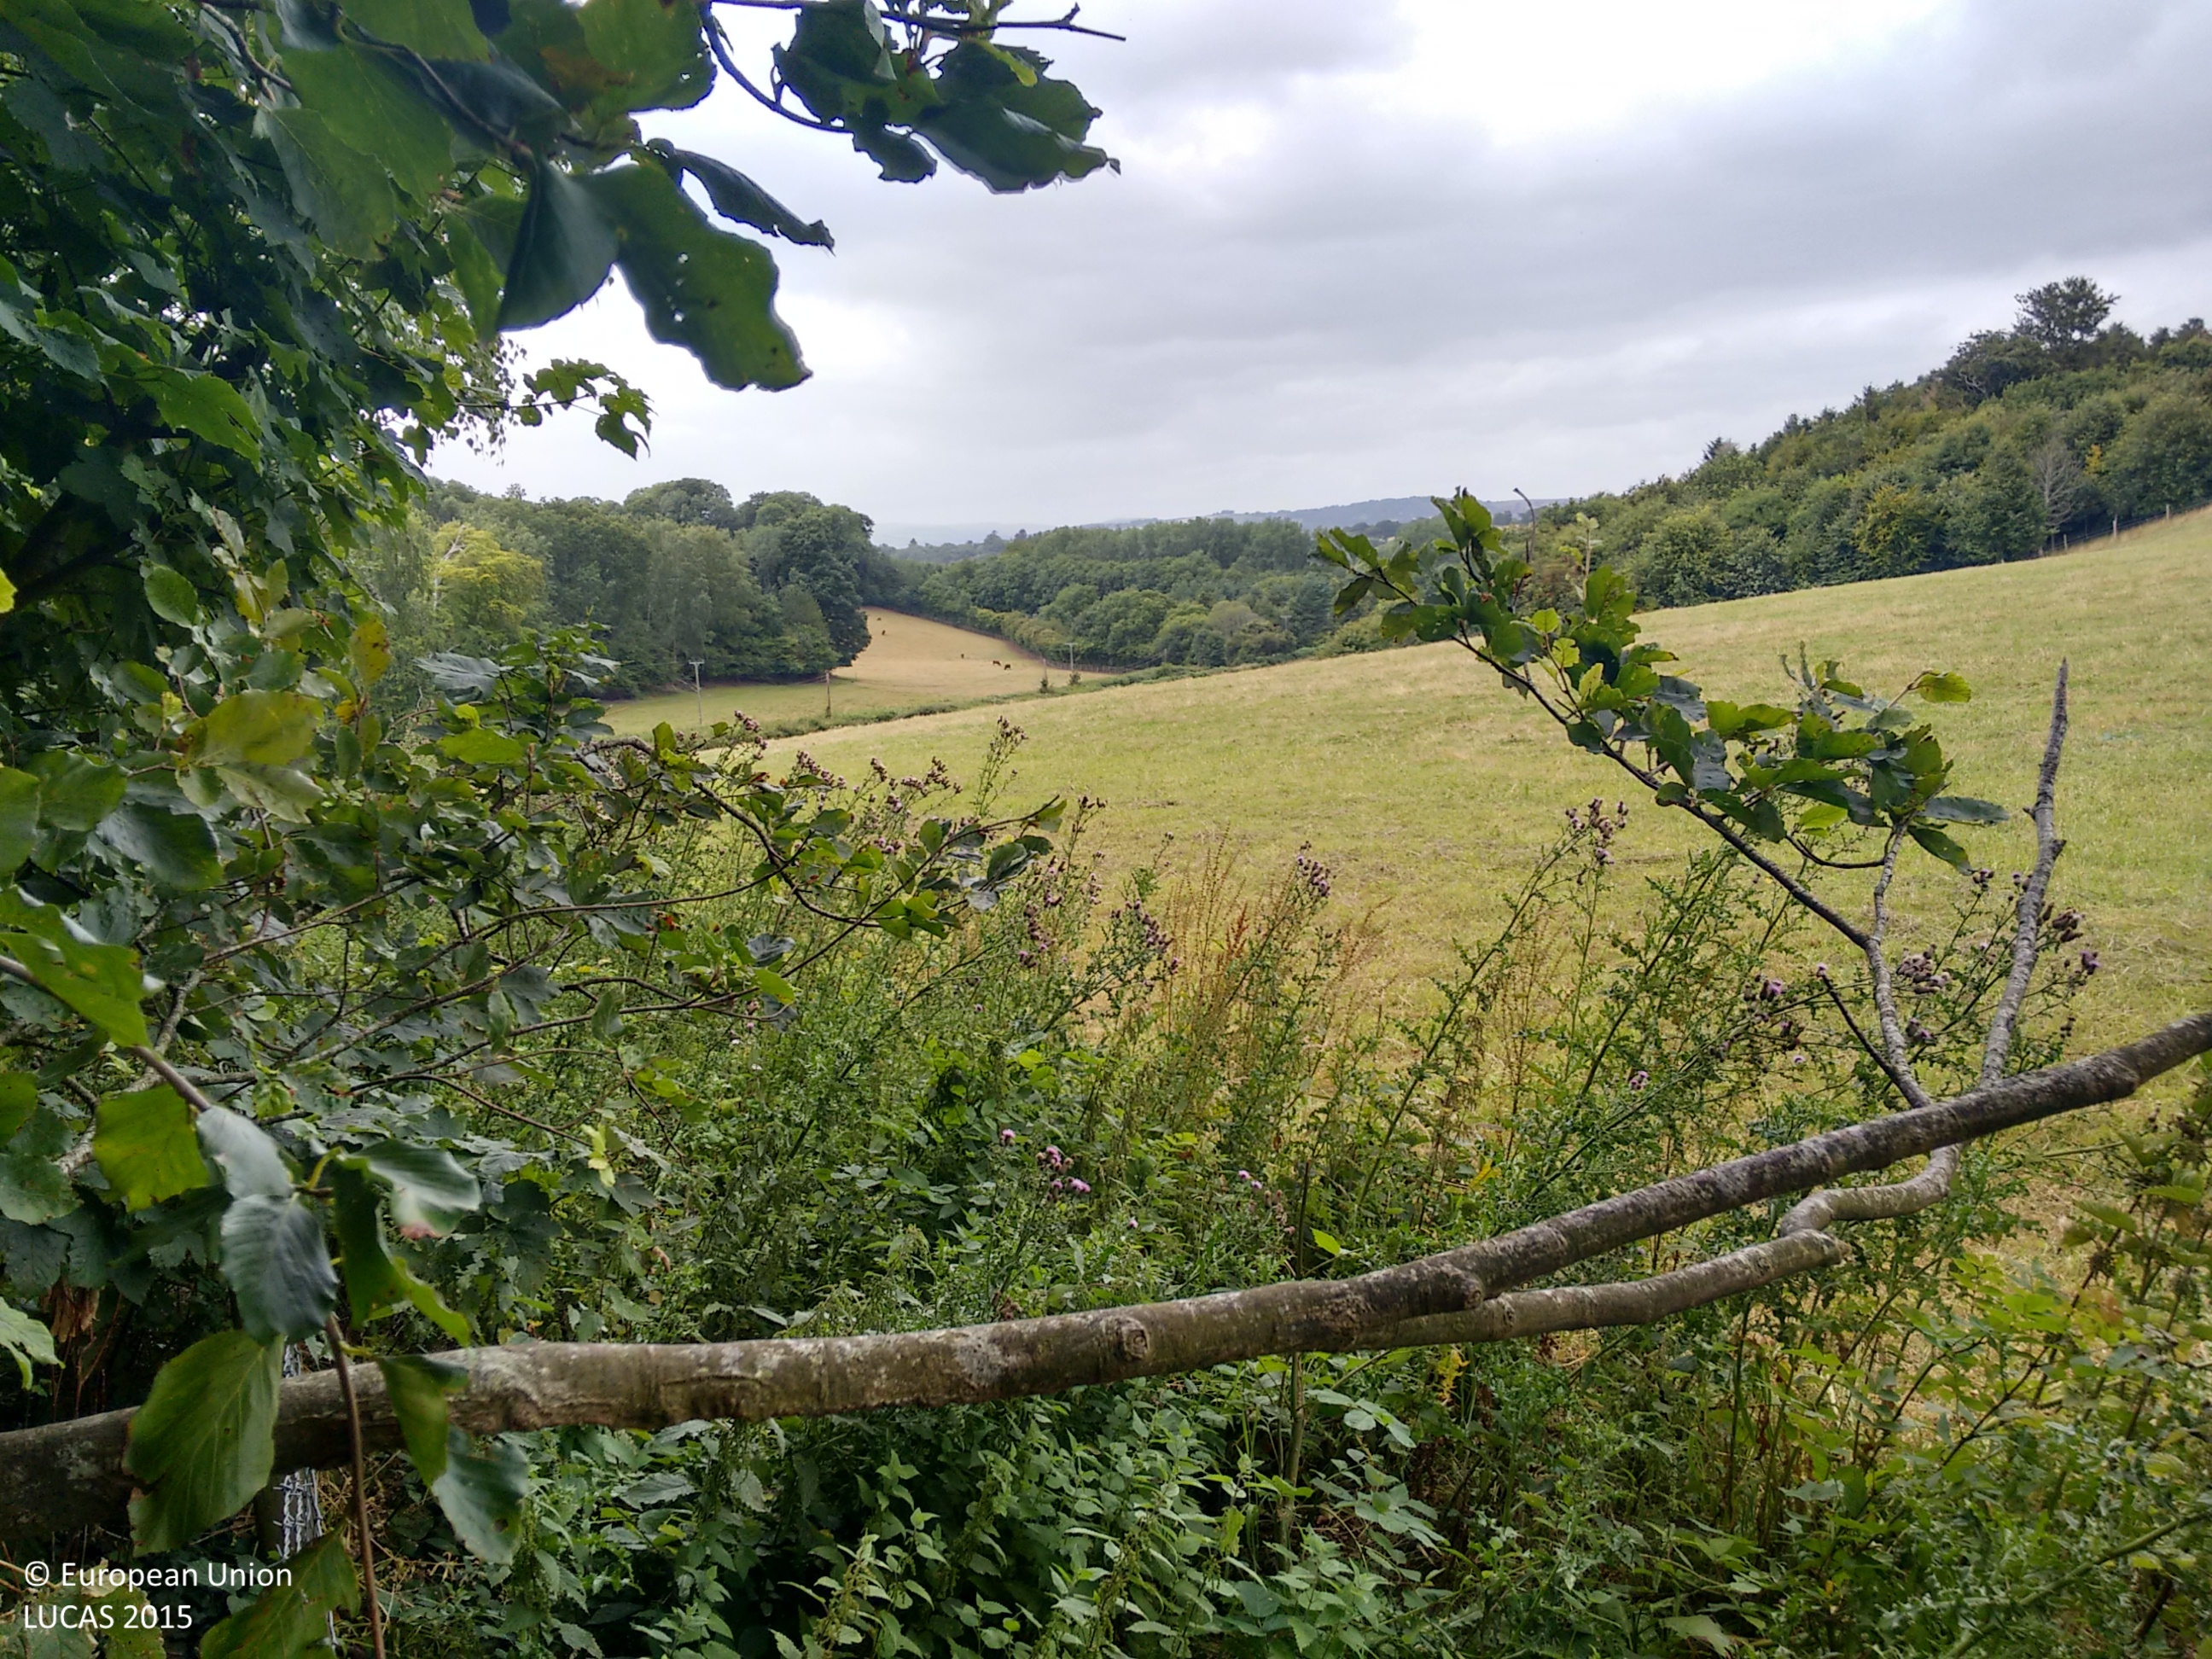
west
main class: Grassland
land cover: Grassland without tree/shrub cover
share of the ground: > 75 %
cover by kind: herbaceous plants 100 %
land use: Agriculture (excluding fallow land and kitchen gardens)
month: August
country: GB
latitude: 50.5896
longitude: -3.5747
